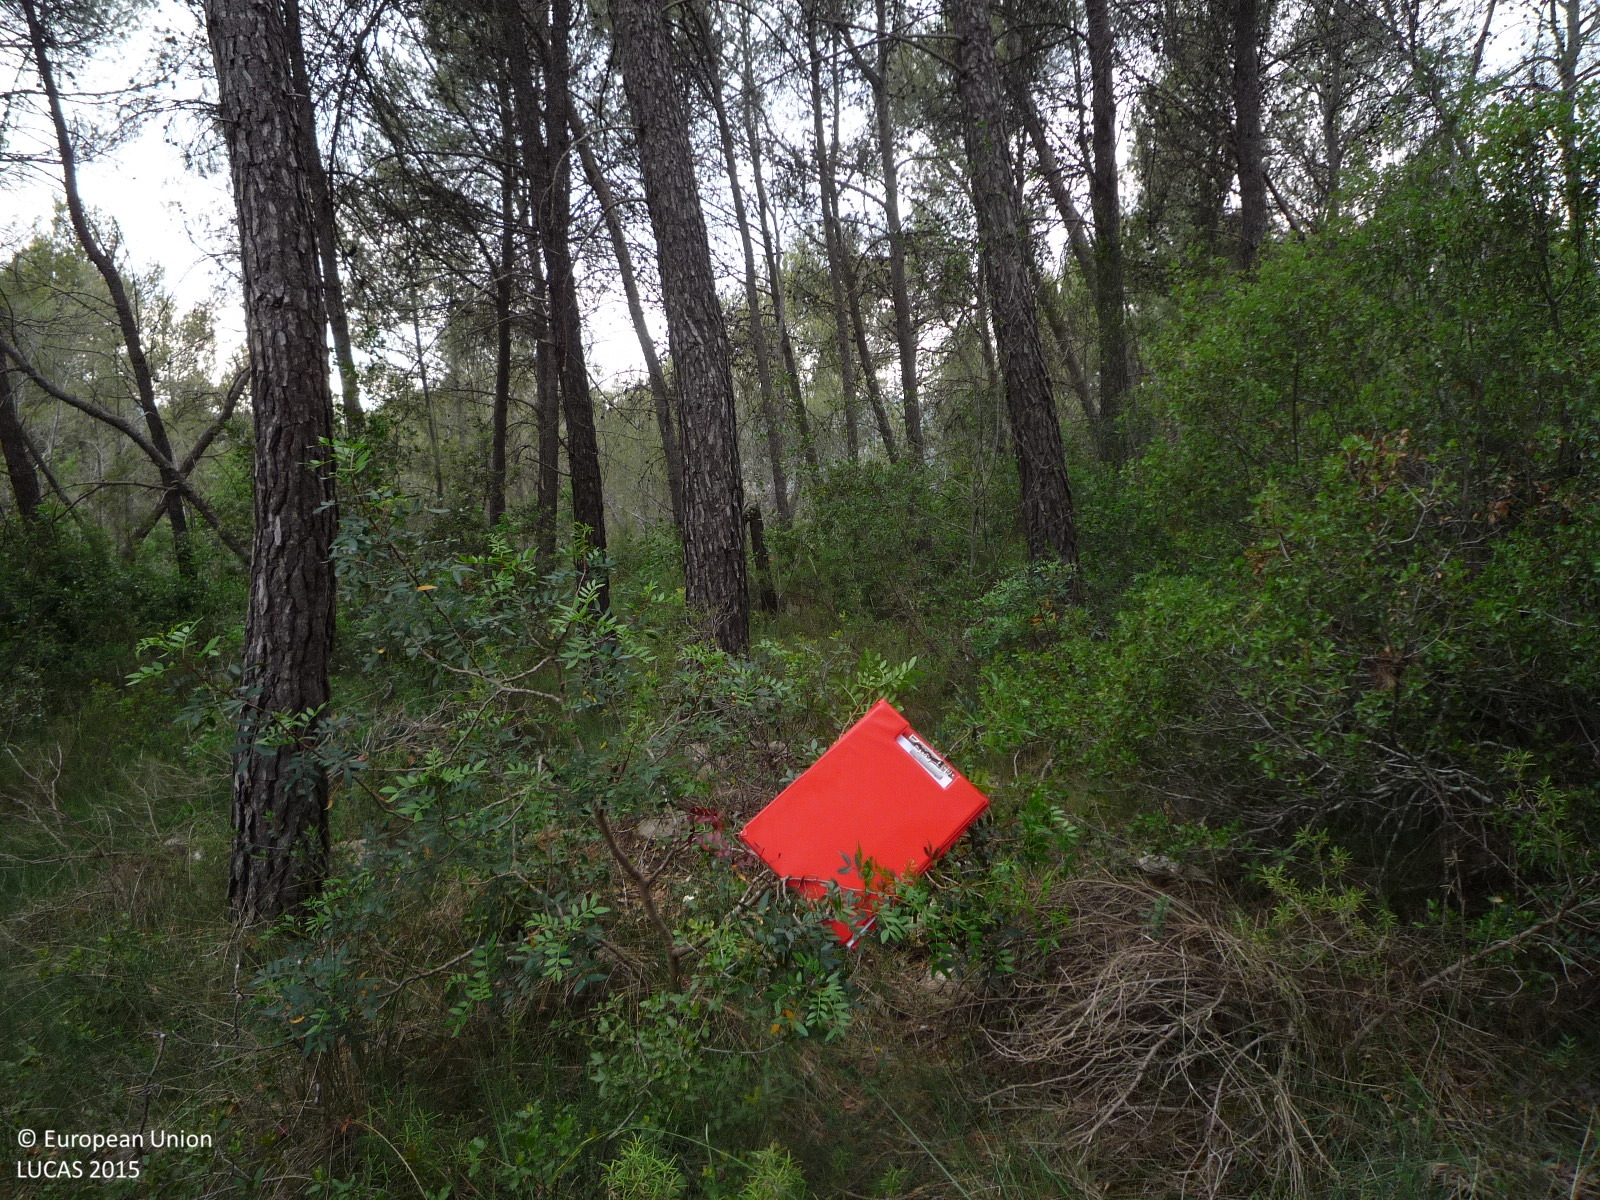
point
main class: Woodland
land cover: Pine dominated coniferous woodland
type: coniferous forest of the mediterranean region
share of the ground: > 75 %
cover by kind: coniferous forest trees 90 %, broadleaved forest trees 10 %
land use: Semi-natural and natural areas not in use
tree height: > 5 m
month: June
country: ES
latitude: 41.8279
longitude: 1.9840
